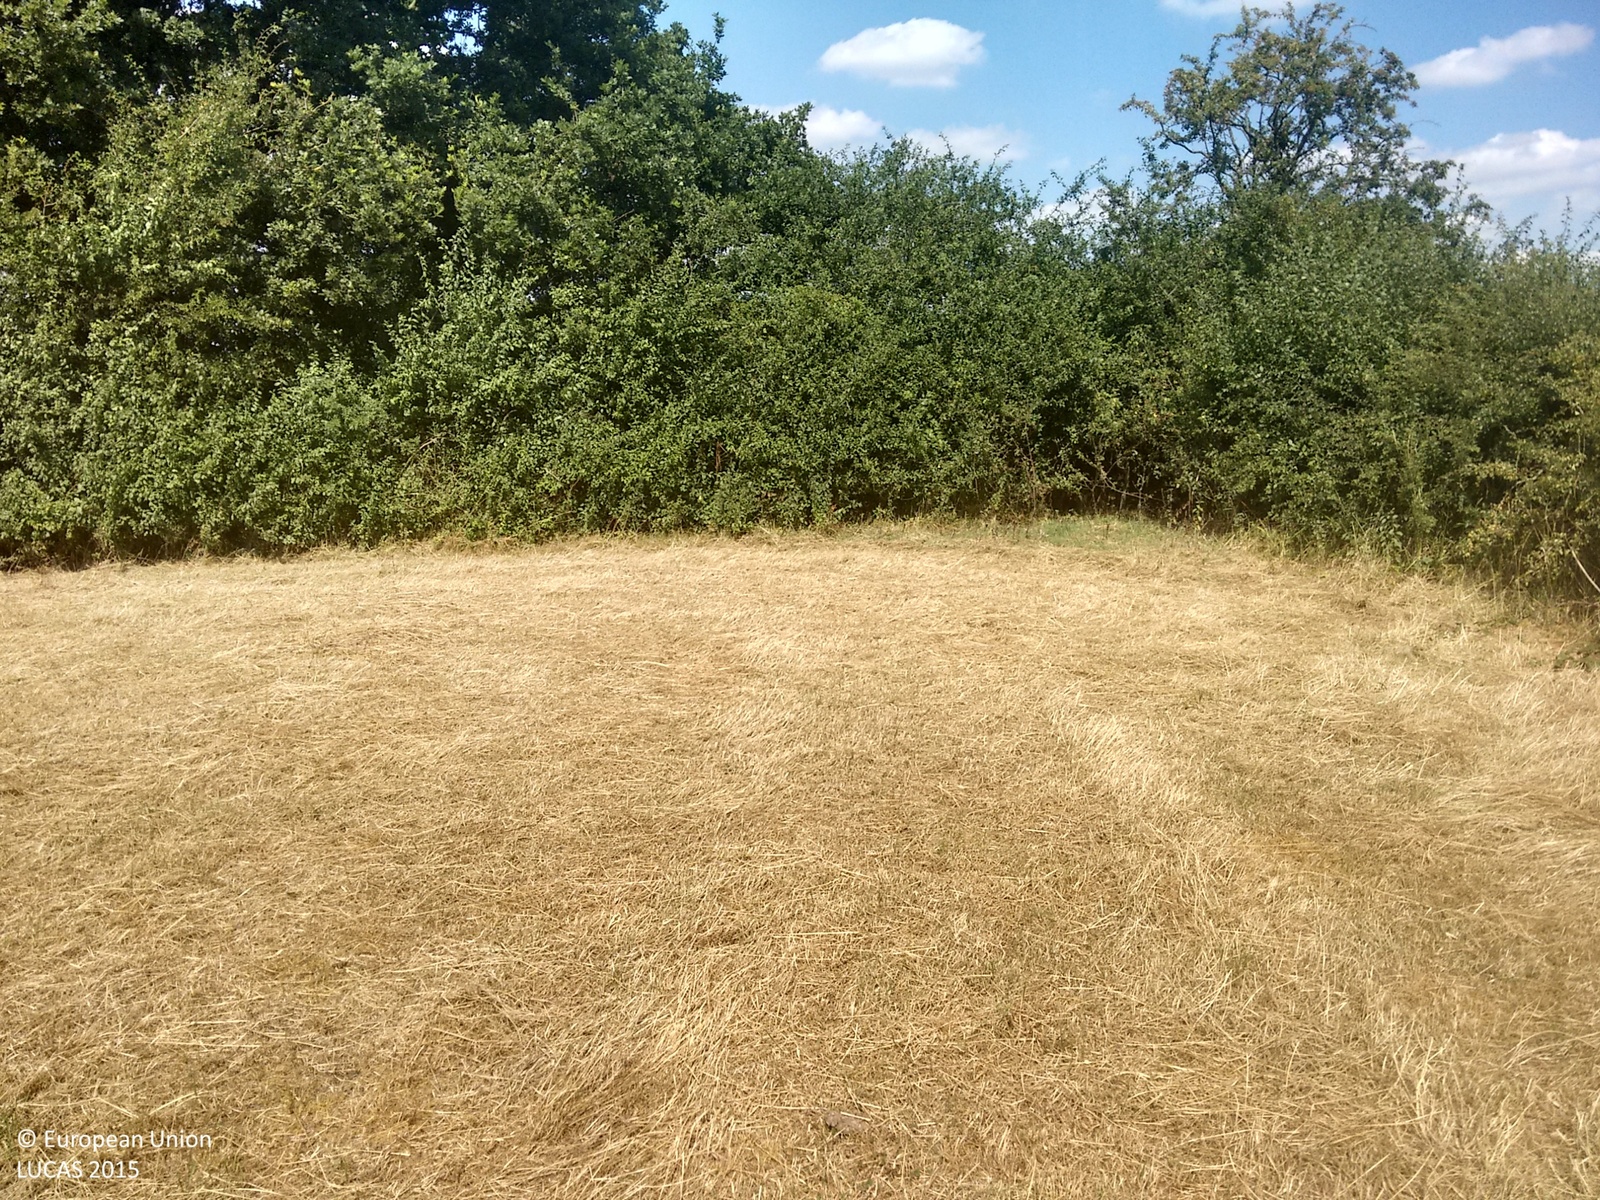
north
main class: Grassland
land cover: Grassland without tree/shrub cover
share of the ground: > 75 %
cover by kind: herbaceous plants 100 %
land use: Agriculture (excluding fallow land and kitchen gardens)
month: August
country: GB
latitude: 52.5685
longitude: -1.4250
